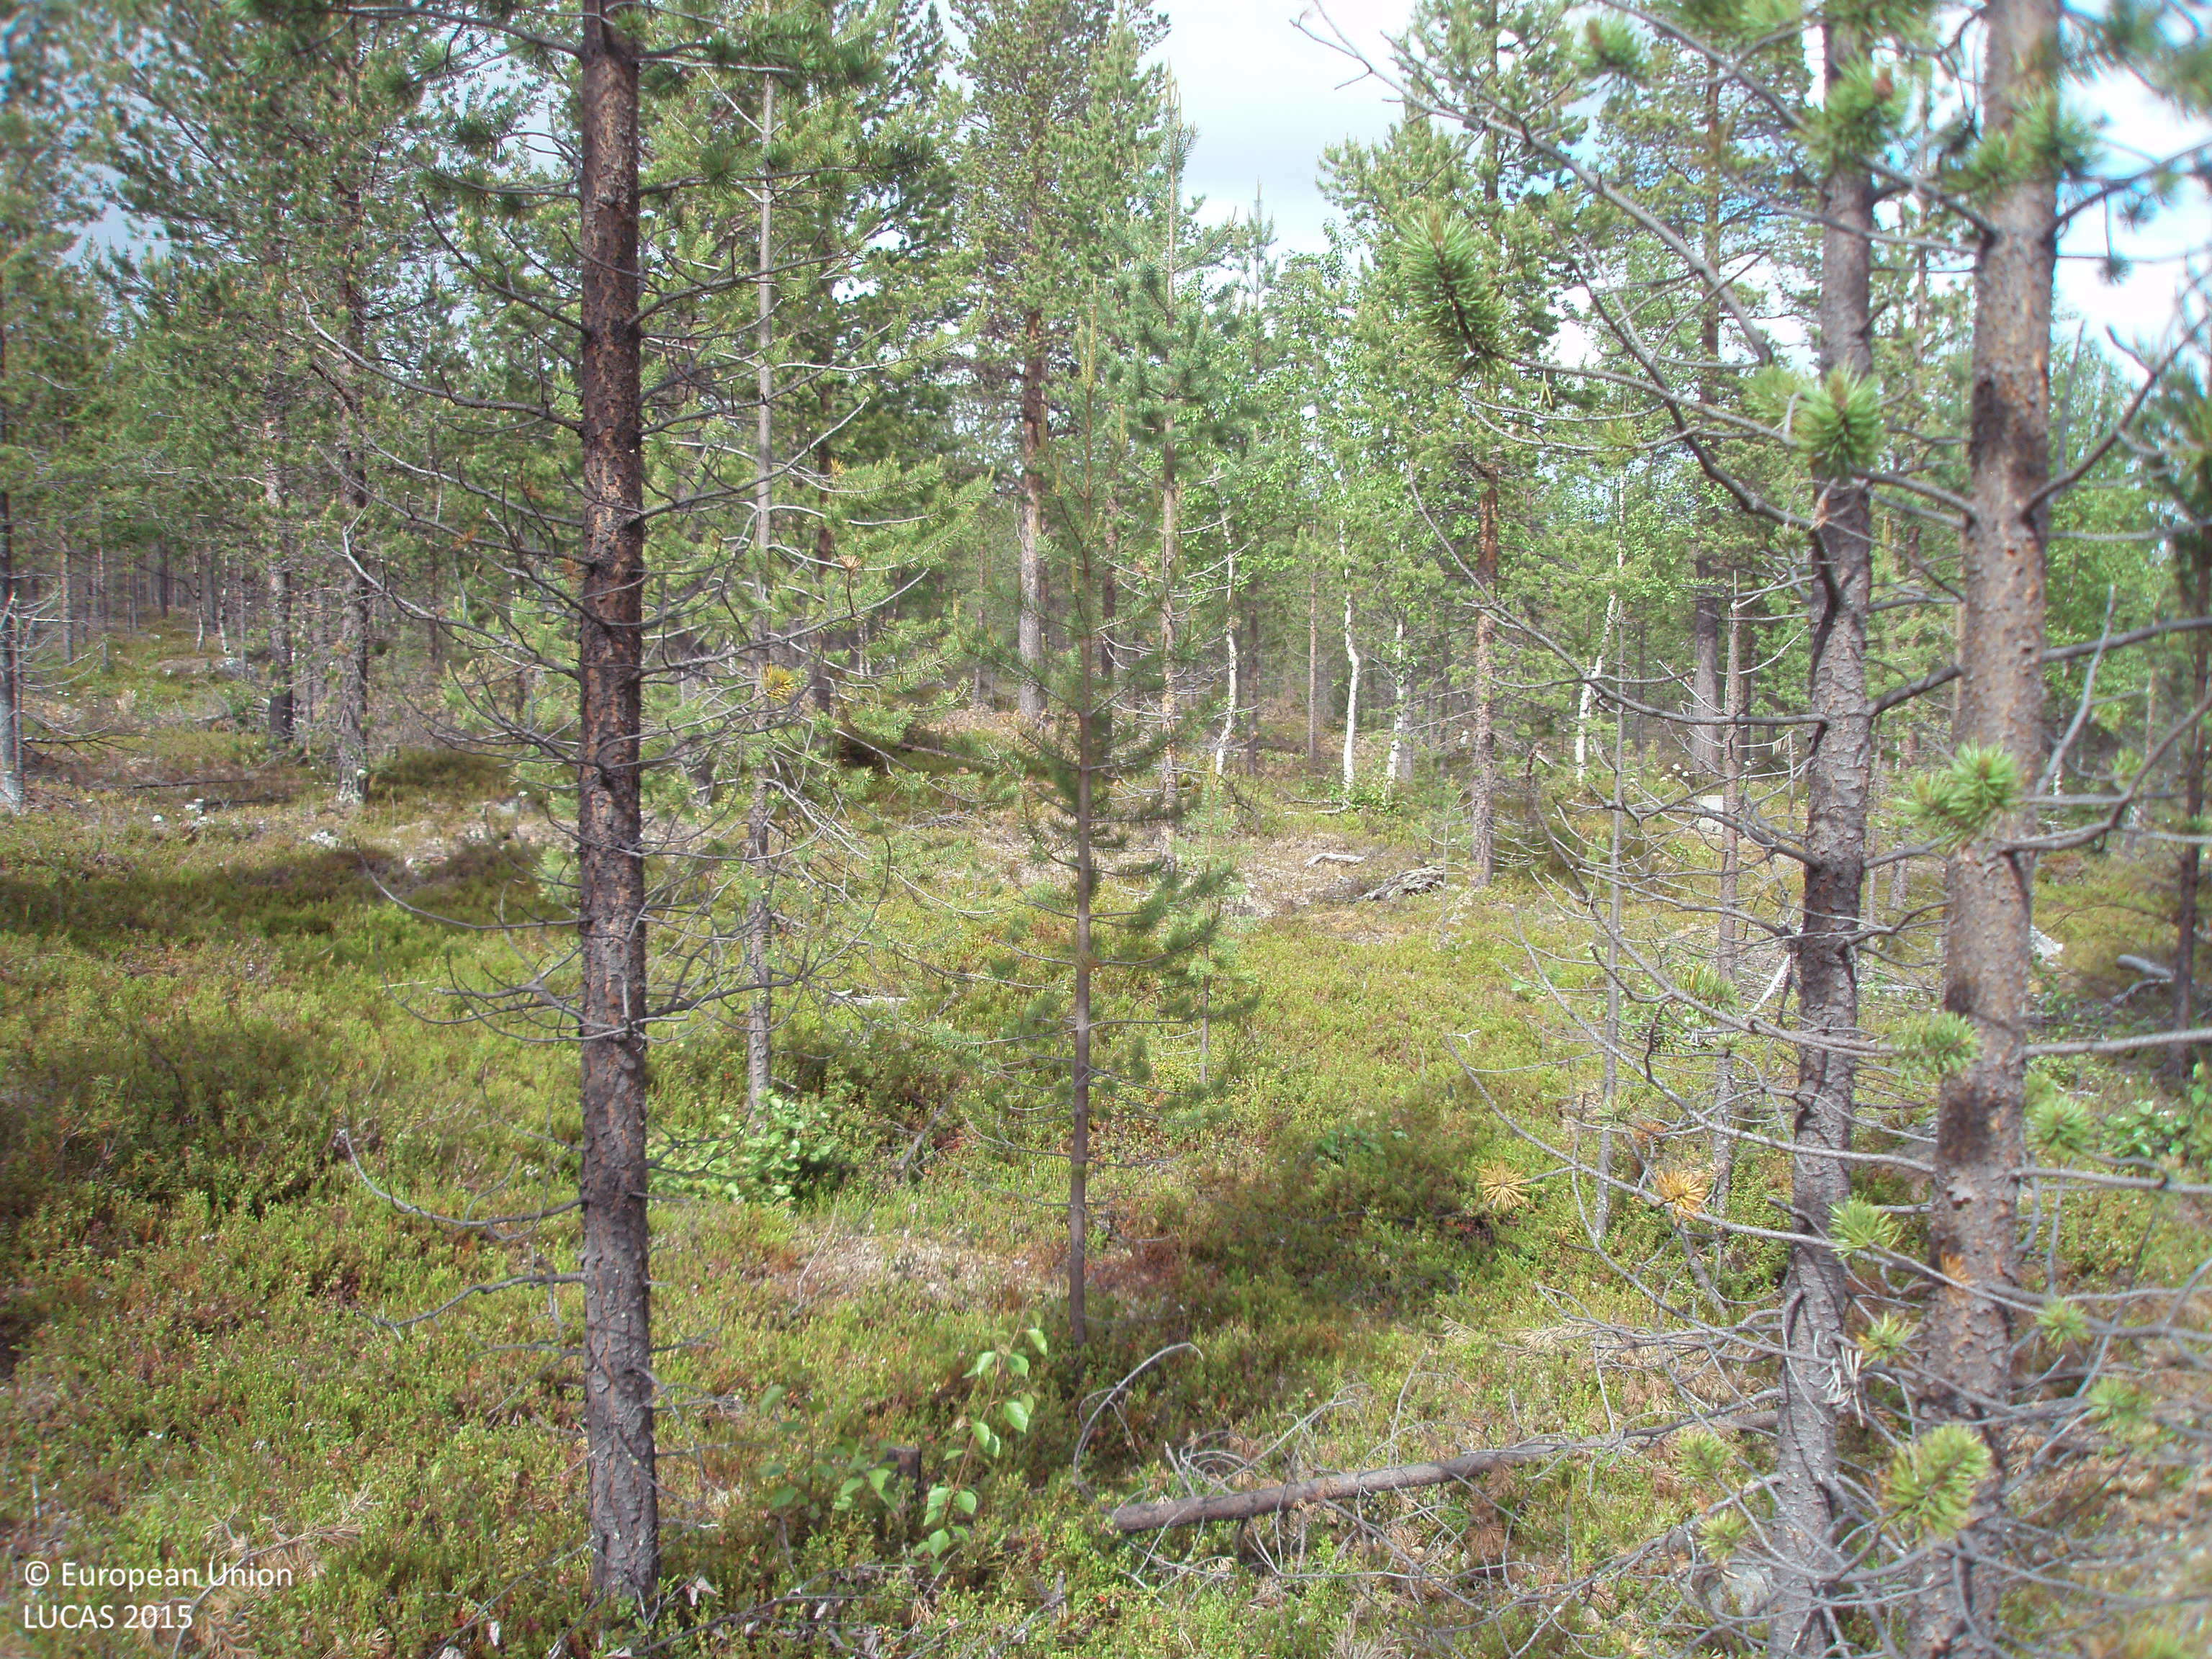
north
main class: Woodland
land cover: Pine dominated mixed woodland
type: boreal forest
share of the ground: 50 - 75 %
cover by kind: coniferous forest trees 40 %, shrubs 40 %, broadleaved forest trees 20 %
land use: Forestry
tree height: > 5 m
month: July
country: FI
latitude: 69.0719
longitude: 27.2978
